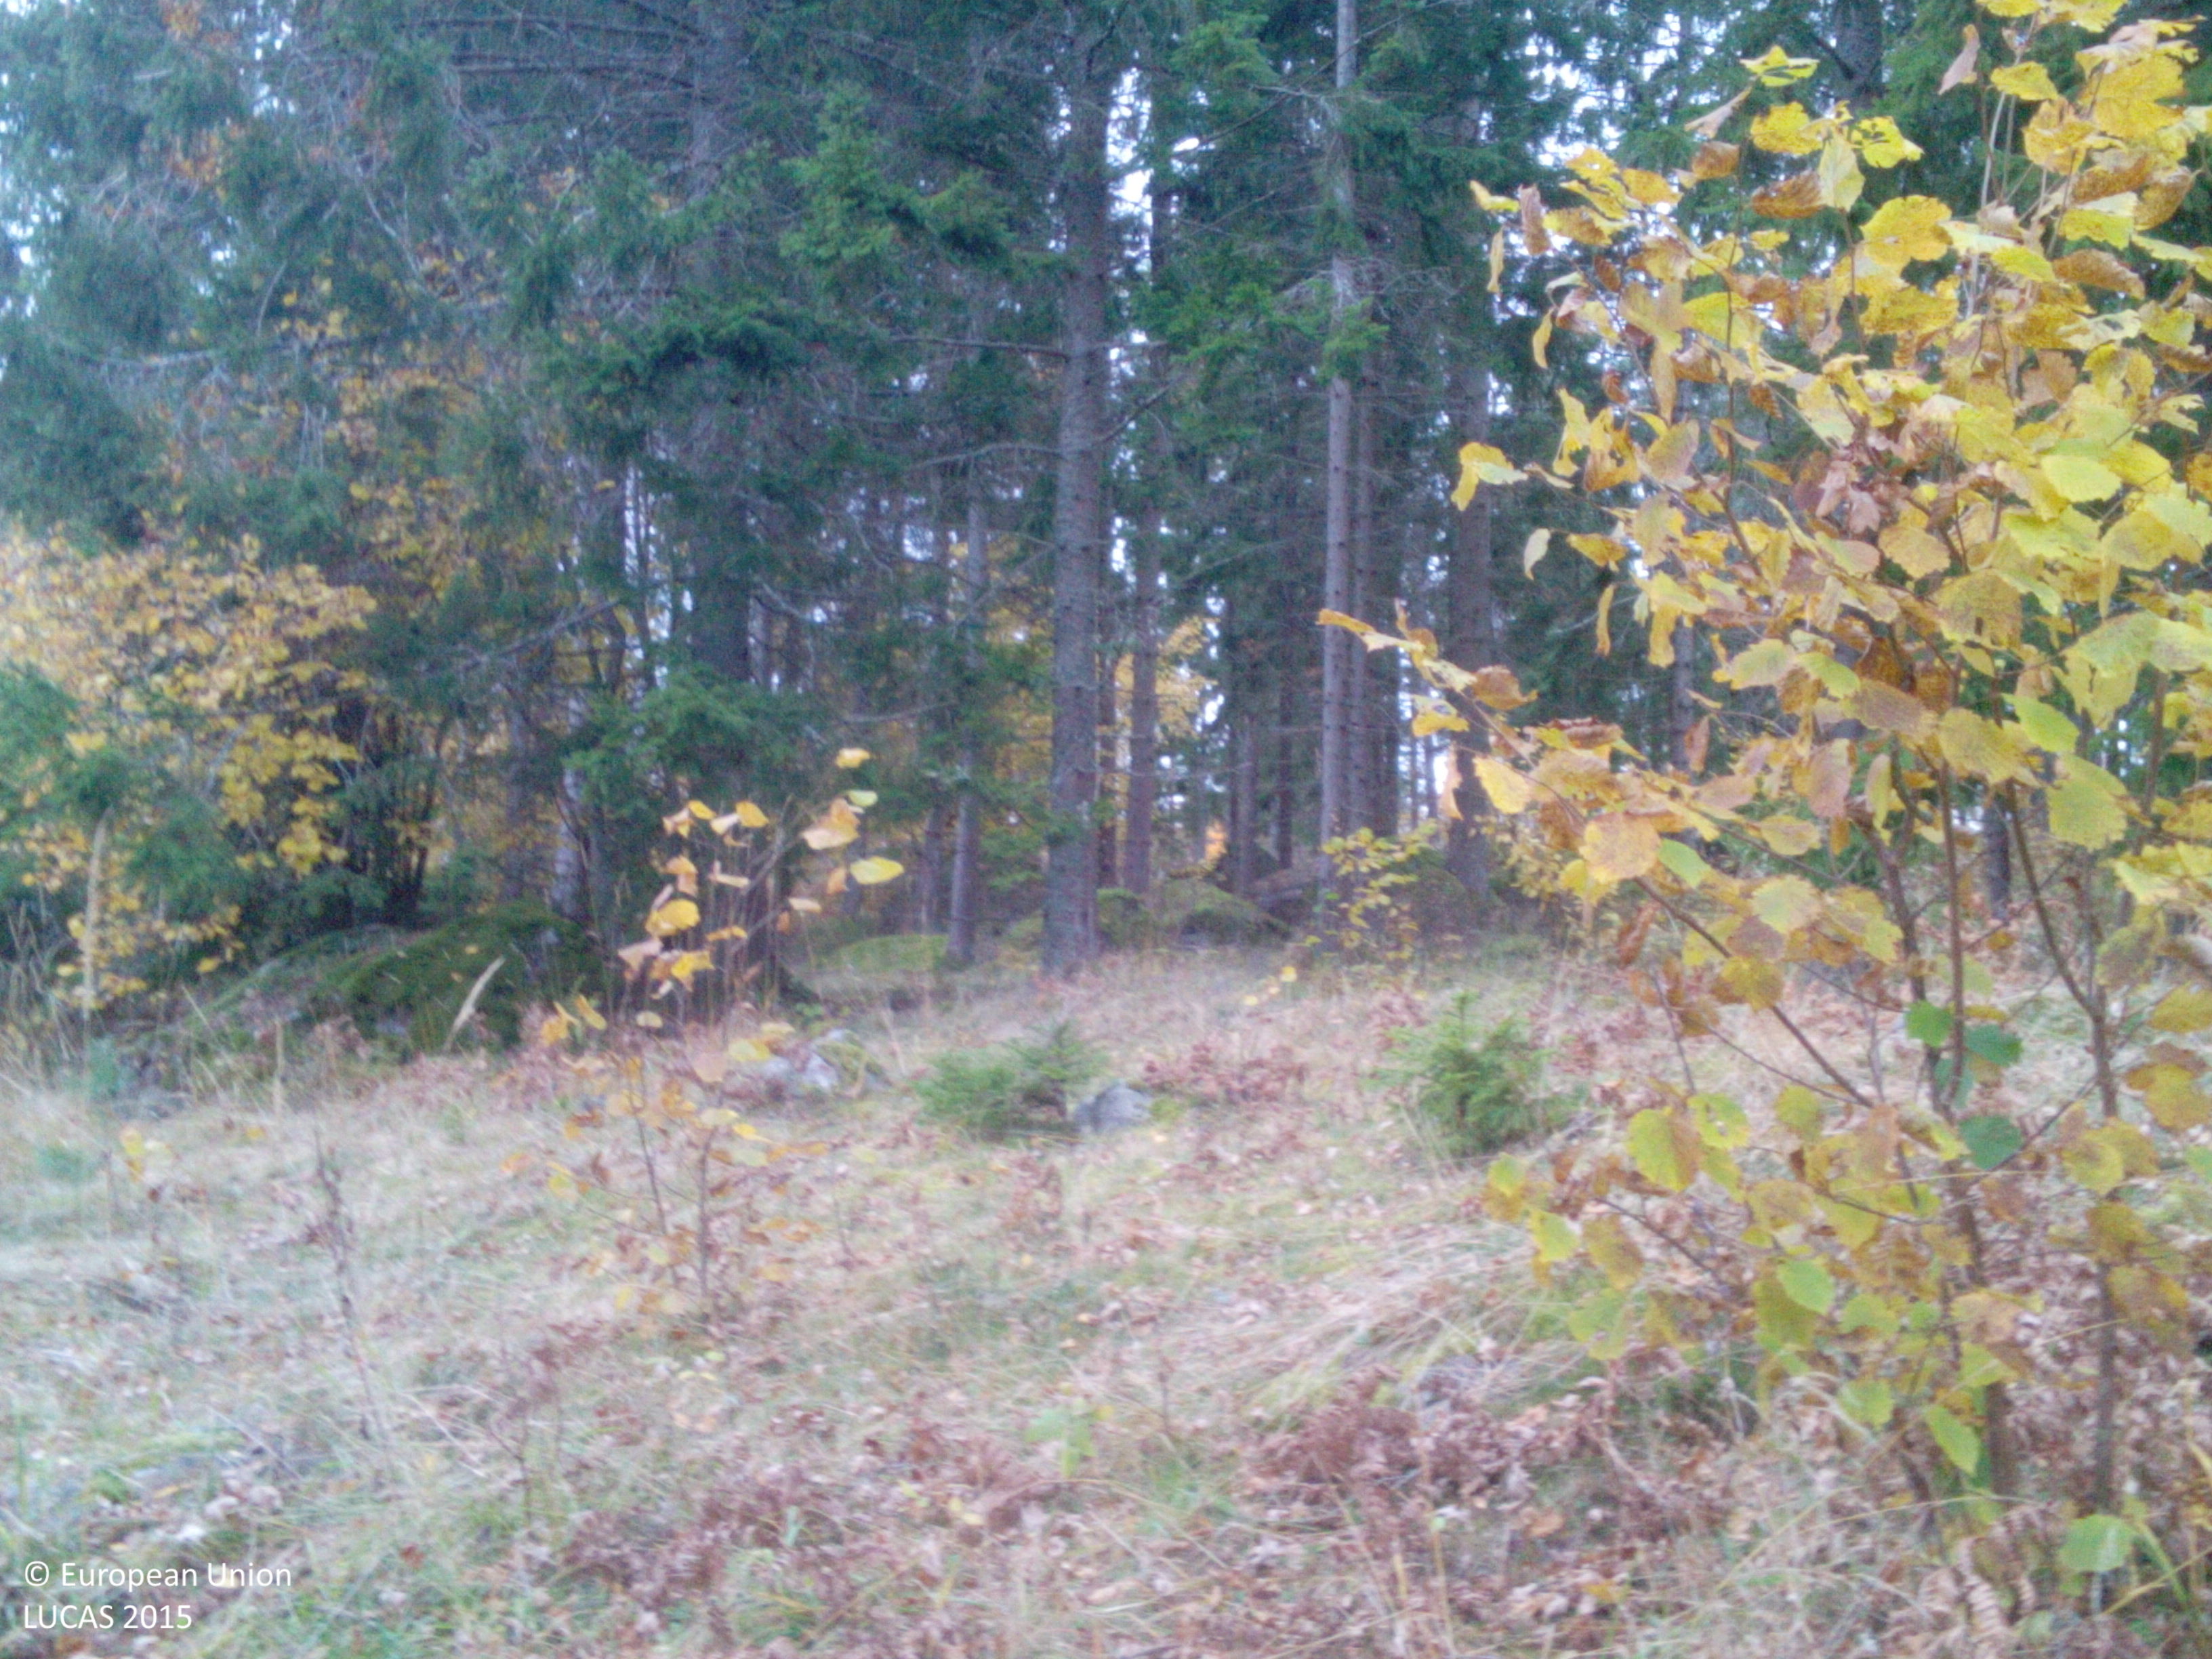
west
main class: Woodland
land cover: Broadleaved woodland
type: hemiboreal forest and nemoral coniferous forest and mixed broadleaved-coniferous forest
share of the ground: 25 - 50 %
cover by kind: herbaceous plants 60 %, broadleaved forest trees 40 %
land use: Agriculture (excluding fallow land and kitchen gardens)
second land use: Forestry
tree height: > 5 m
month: October
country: SE
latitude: 58.9985
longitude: 16.5568
